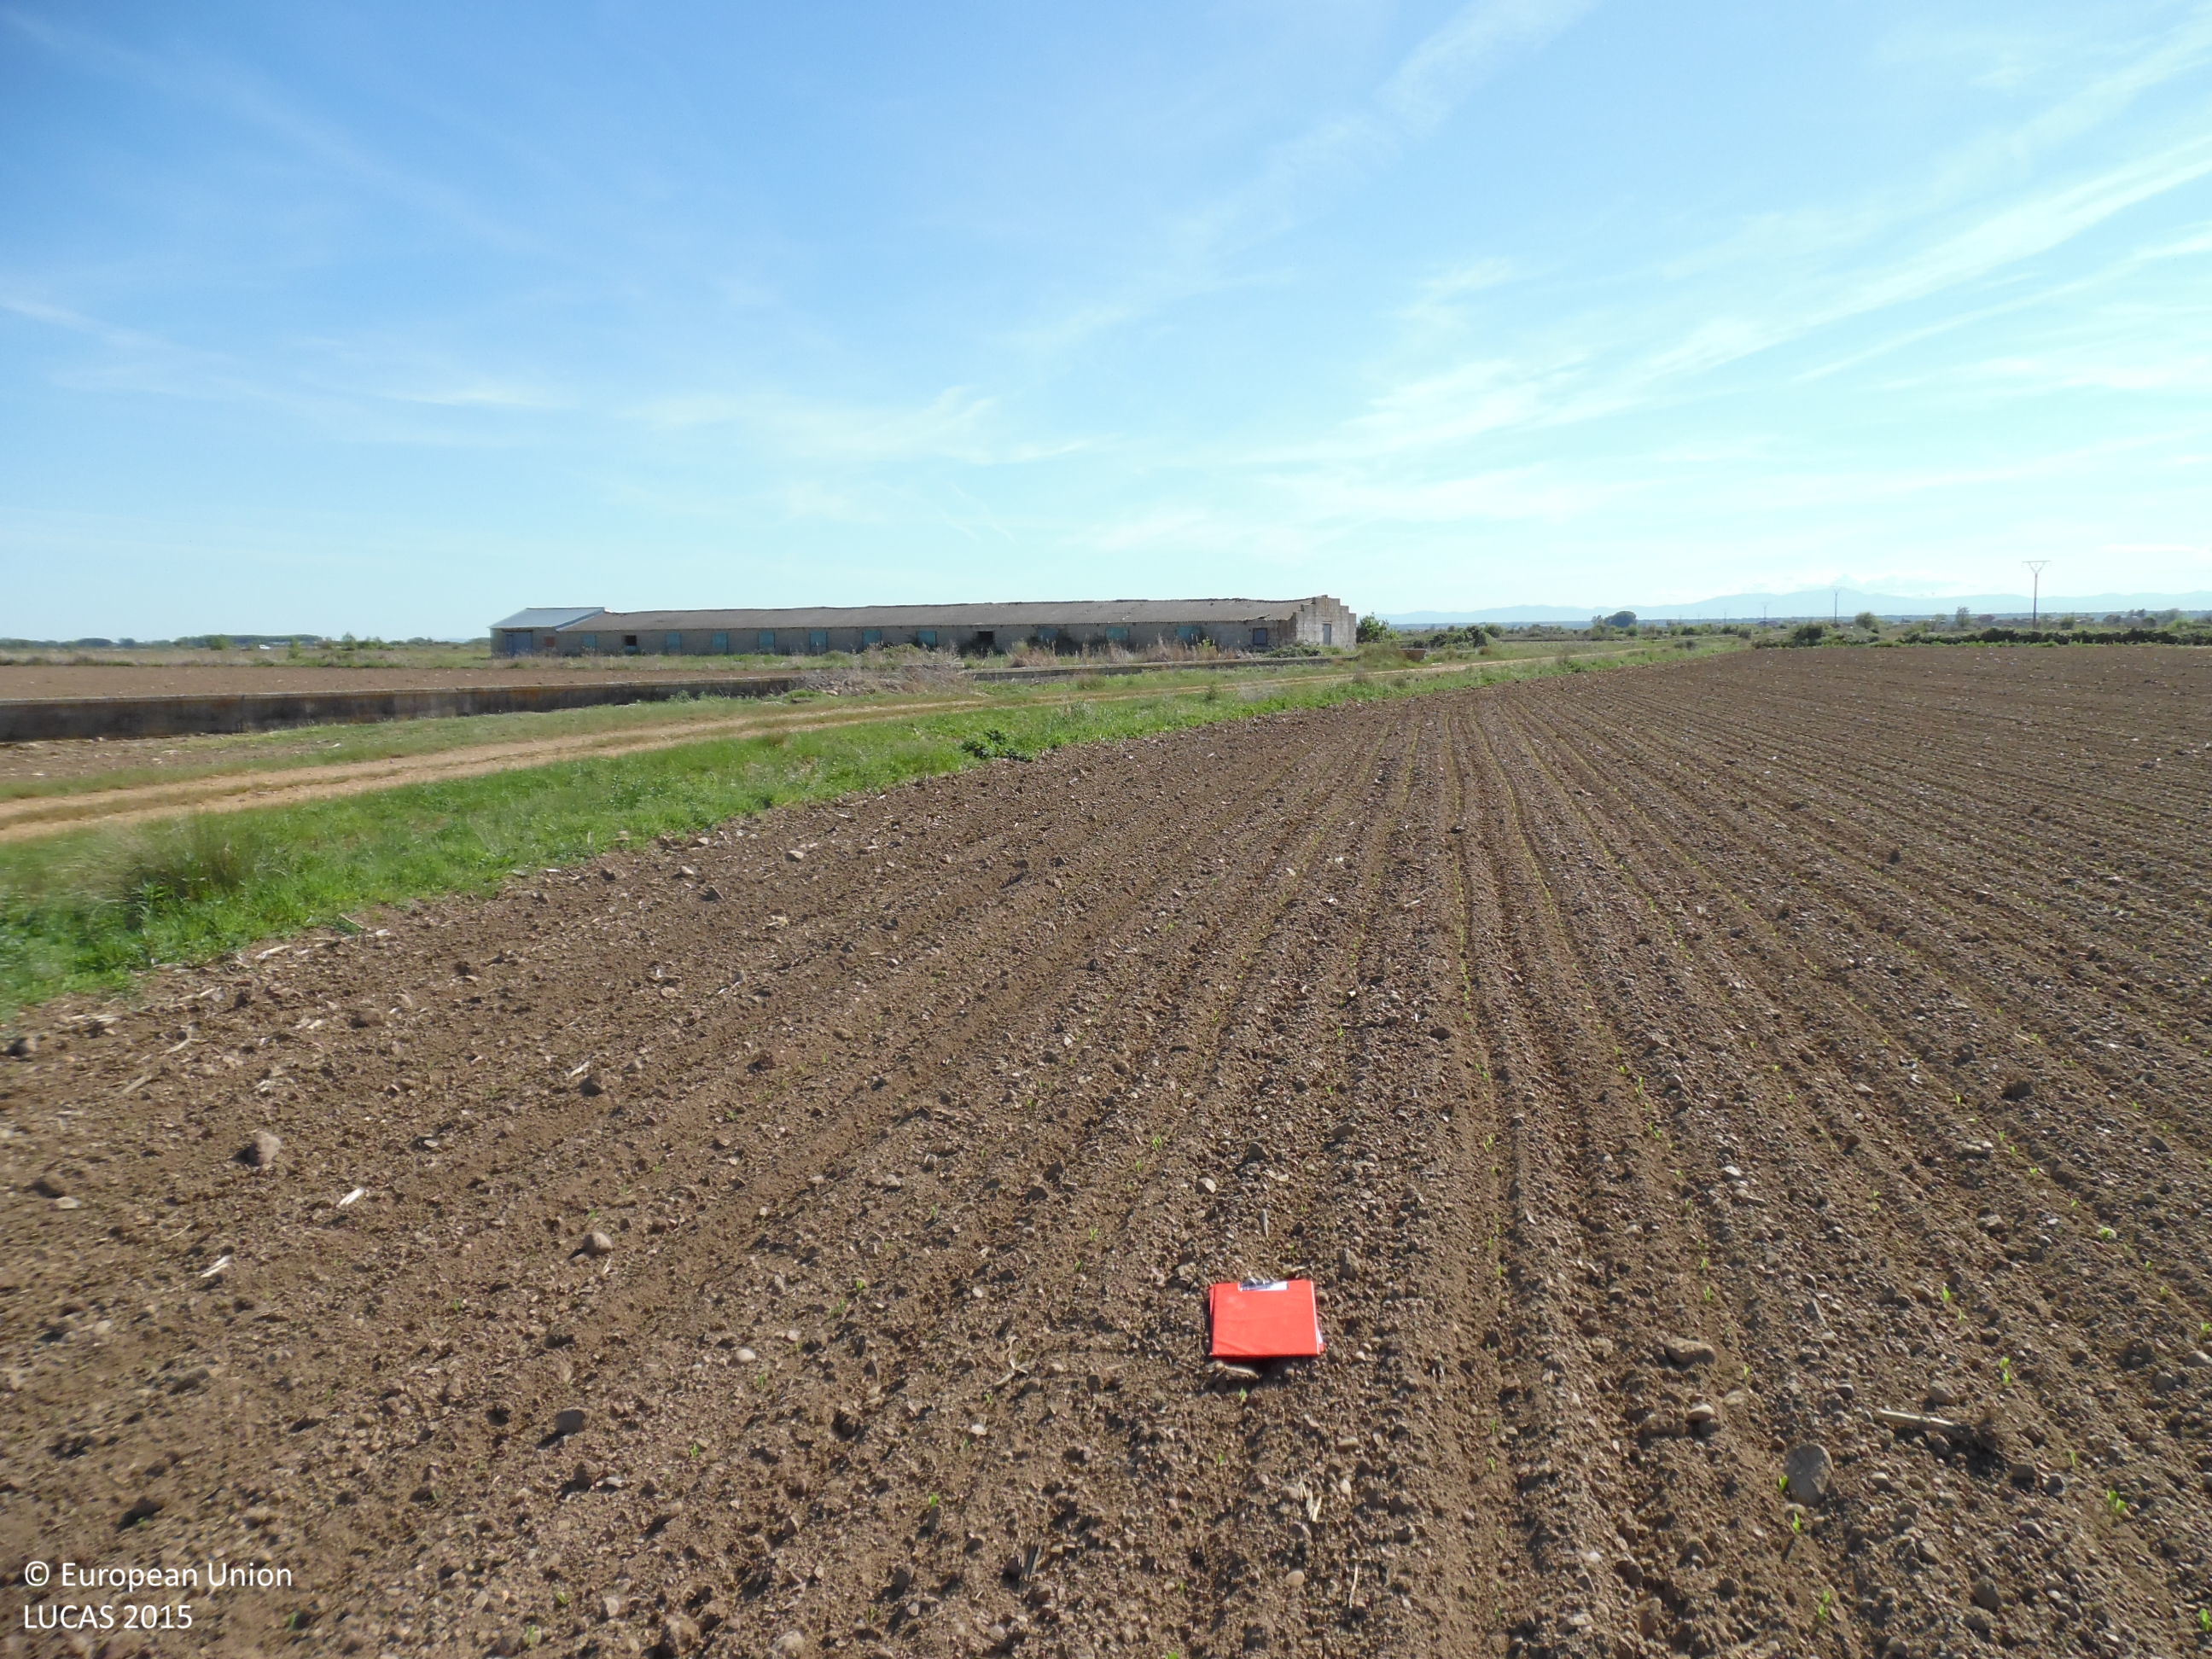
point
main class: Cropland
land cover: Maize
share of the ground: 50 - 75 %
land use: Agriculture (excluding fallow land and kitchen gardens)
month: May
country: ES
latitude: 42.5614
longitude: -5.8022
